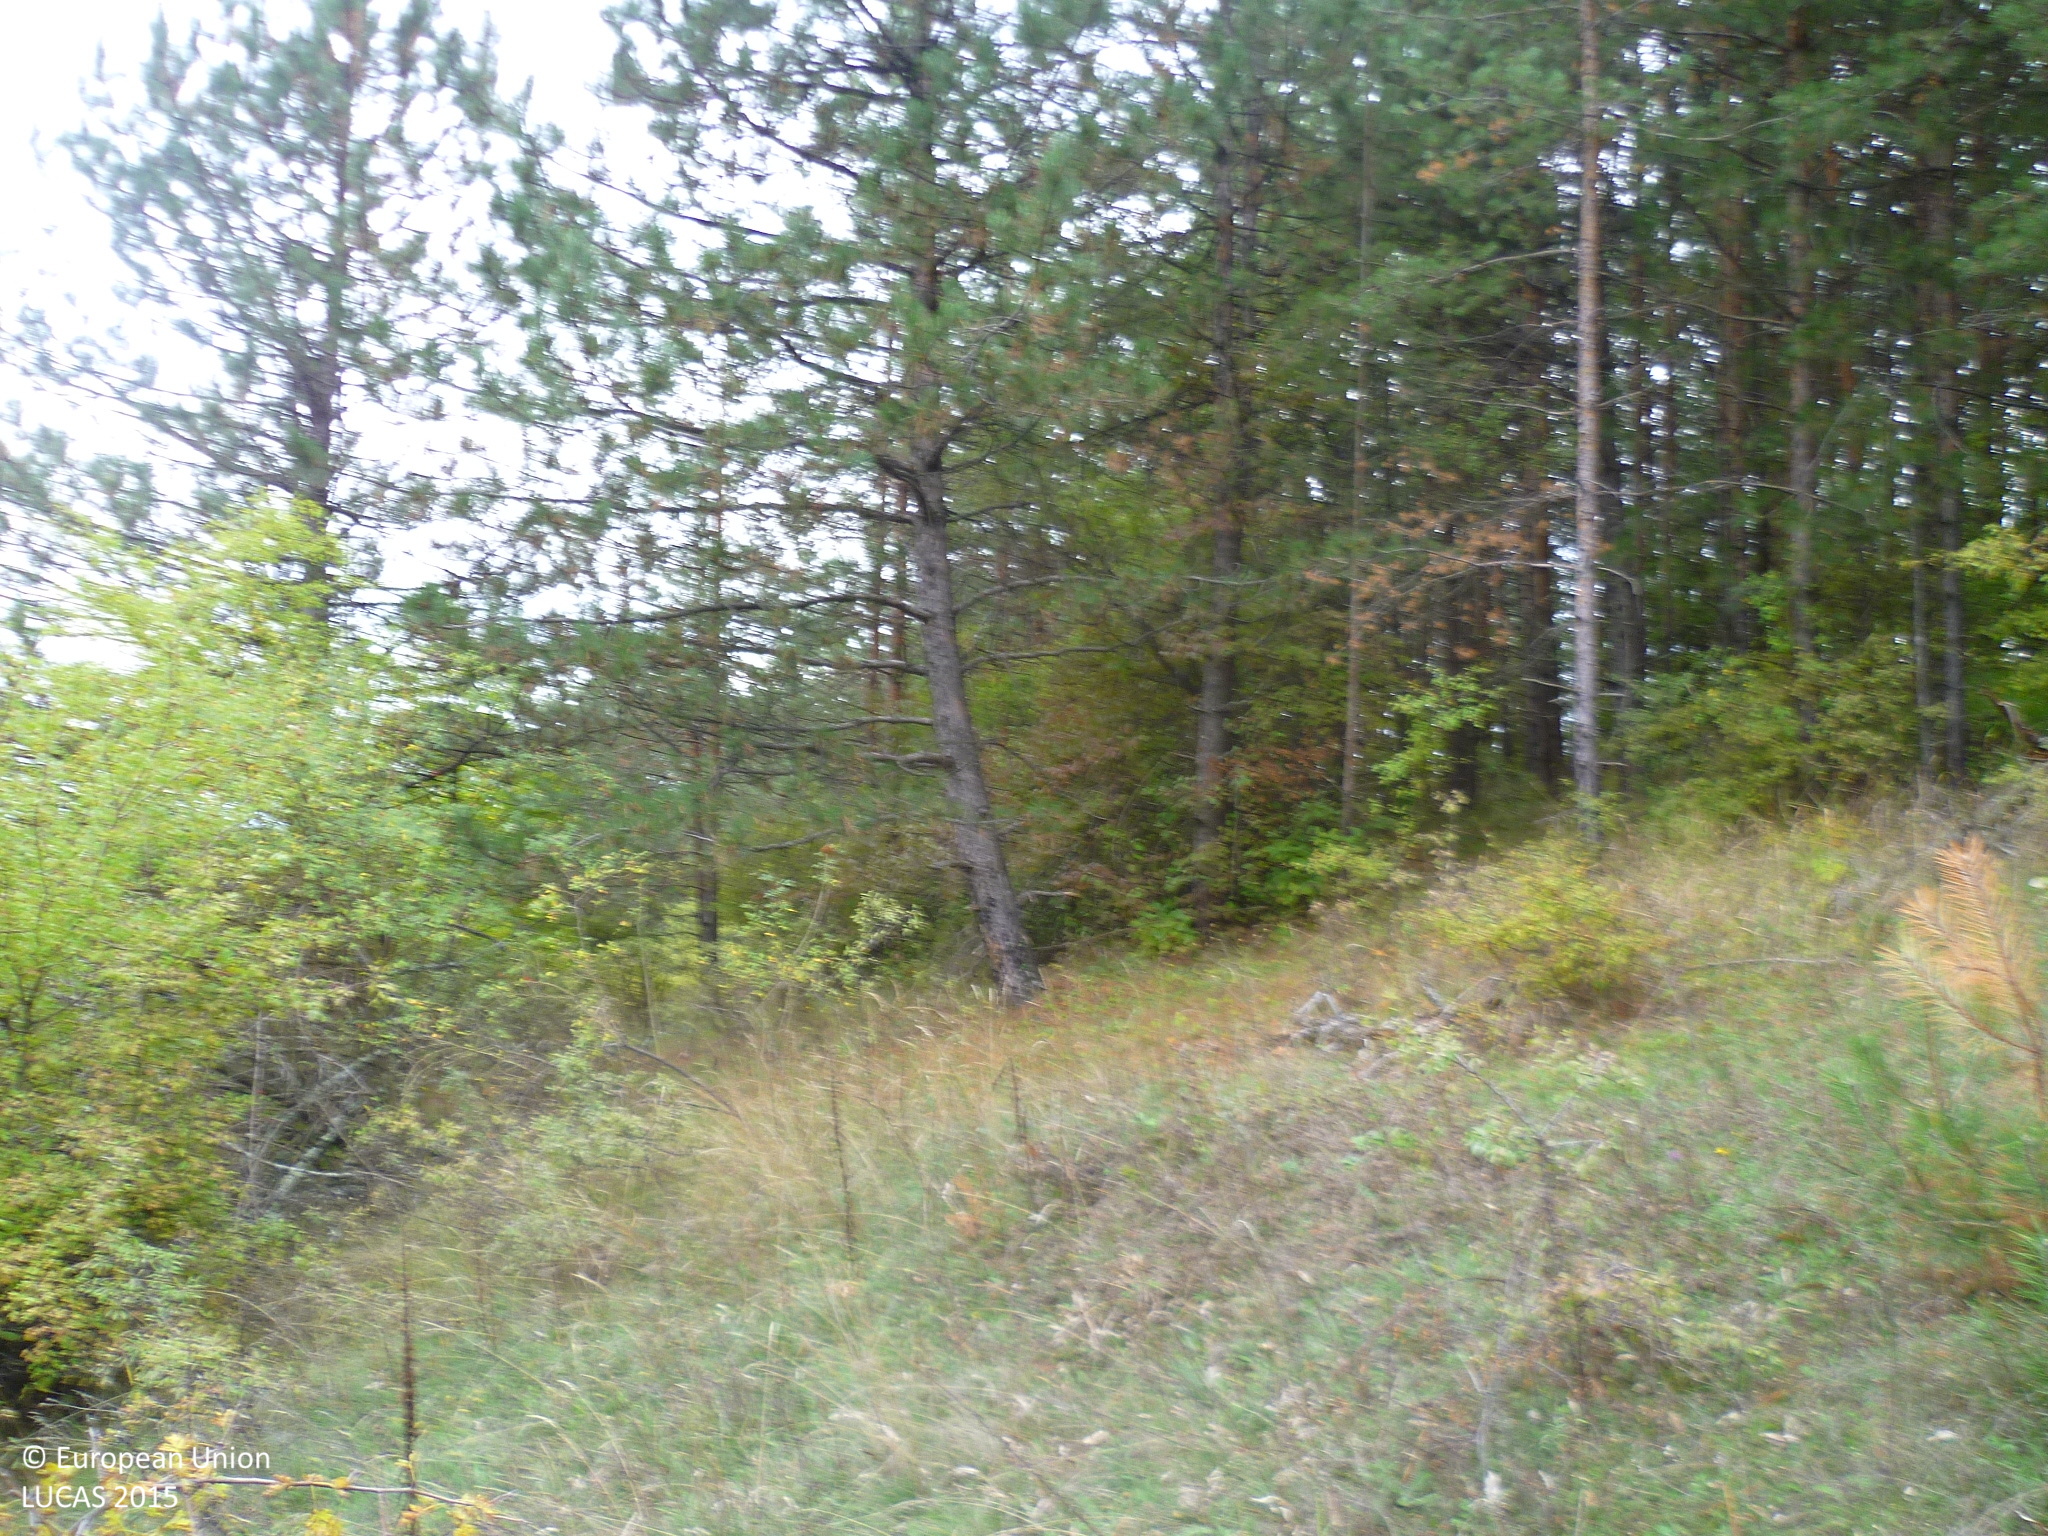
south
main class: Grassland
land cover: Grassland with sparse tree/shrub cover
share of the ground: > 75 %
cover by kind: herbaceous plants 90 %, coniferous forest trees 5 %, shrubs 5 %
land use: Agriculture (excluding fallow land and kitchen gardens)
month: October
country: BG
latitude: 42.8082
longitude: 22.7825
